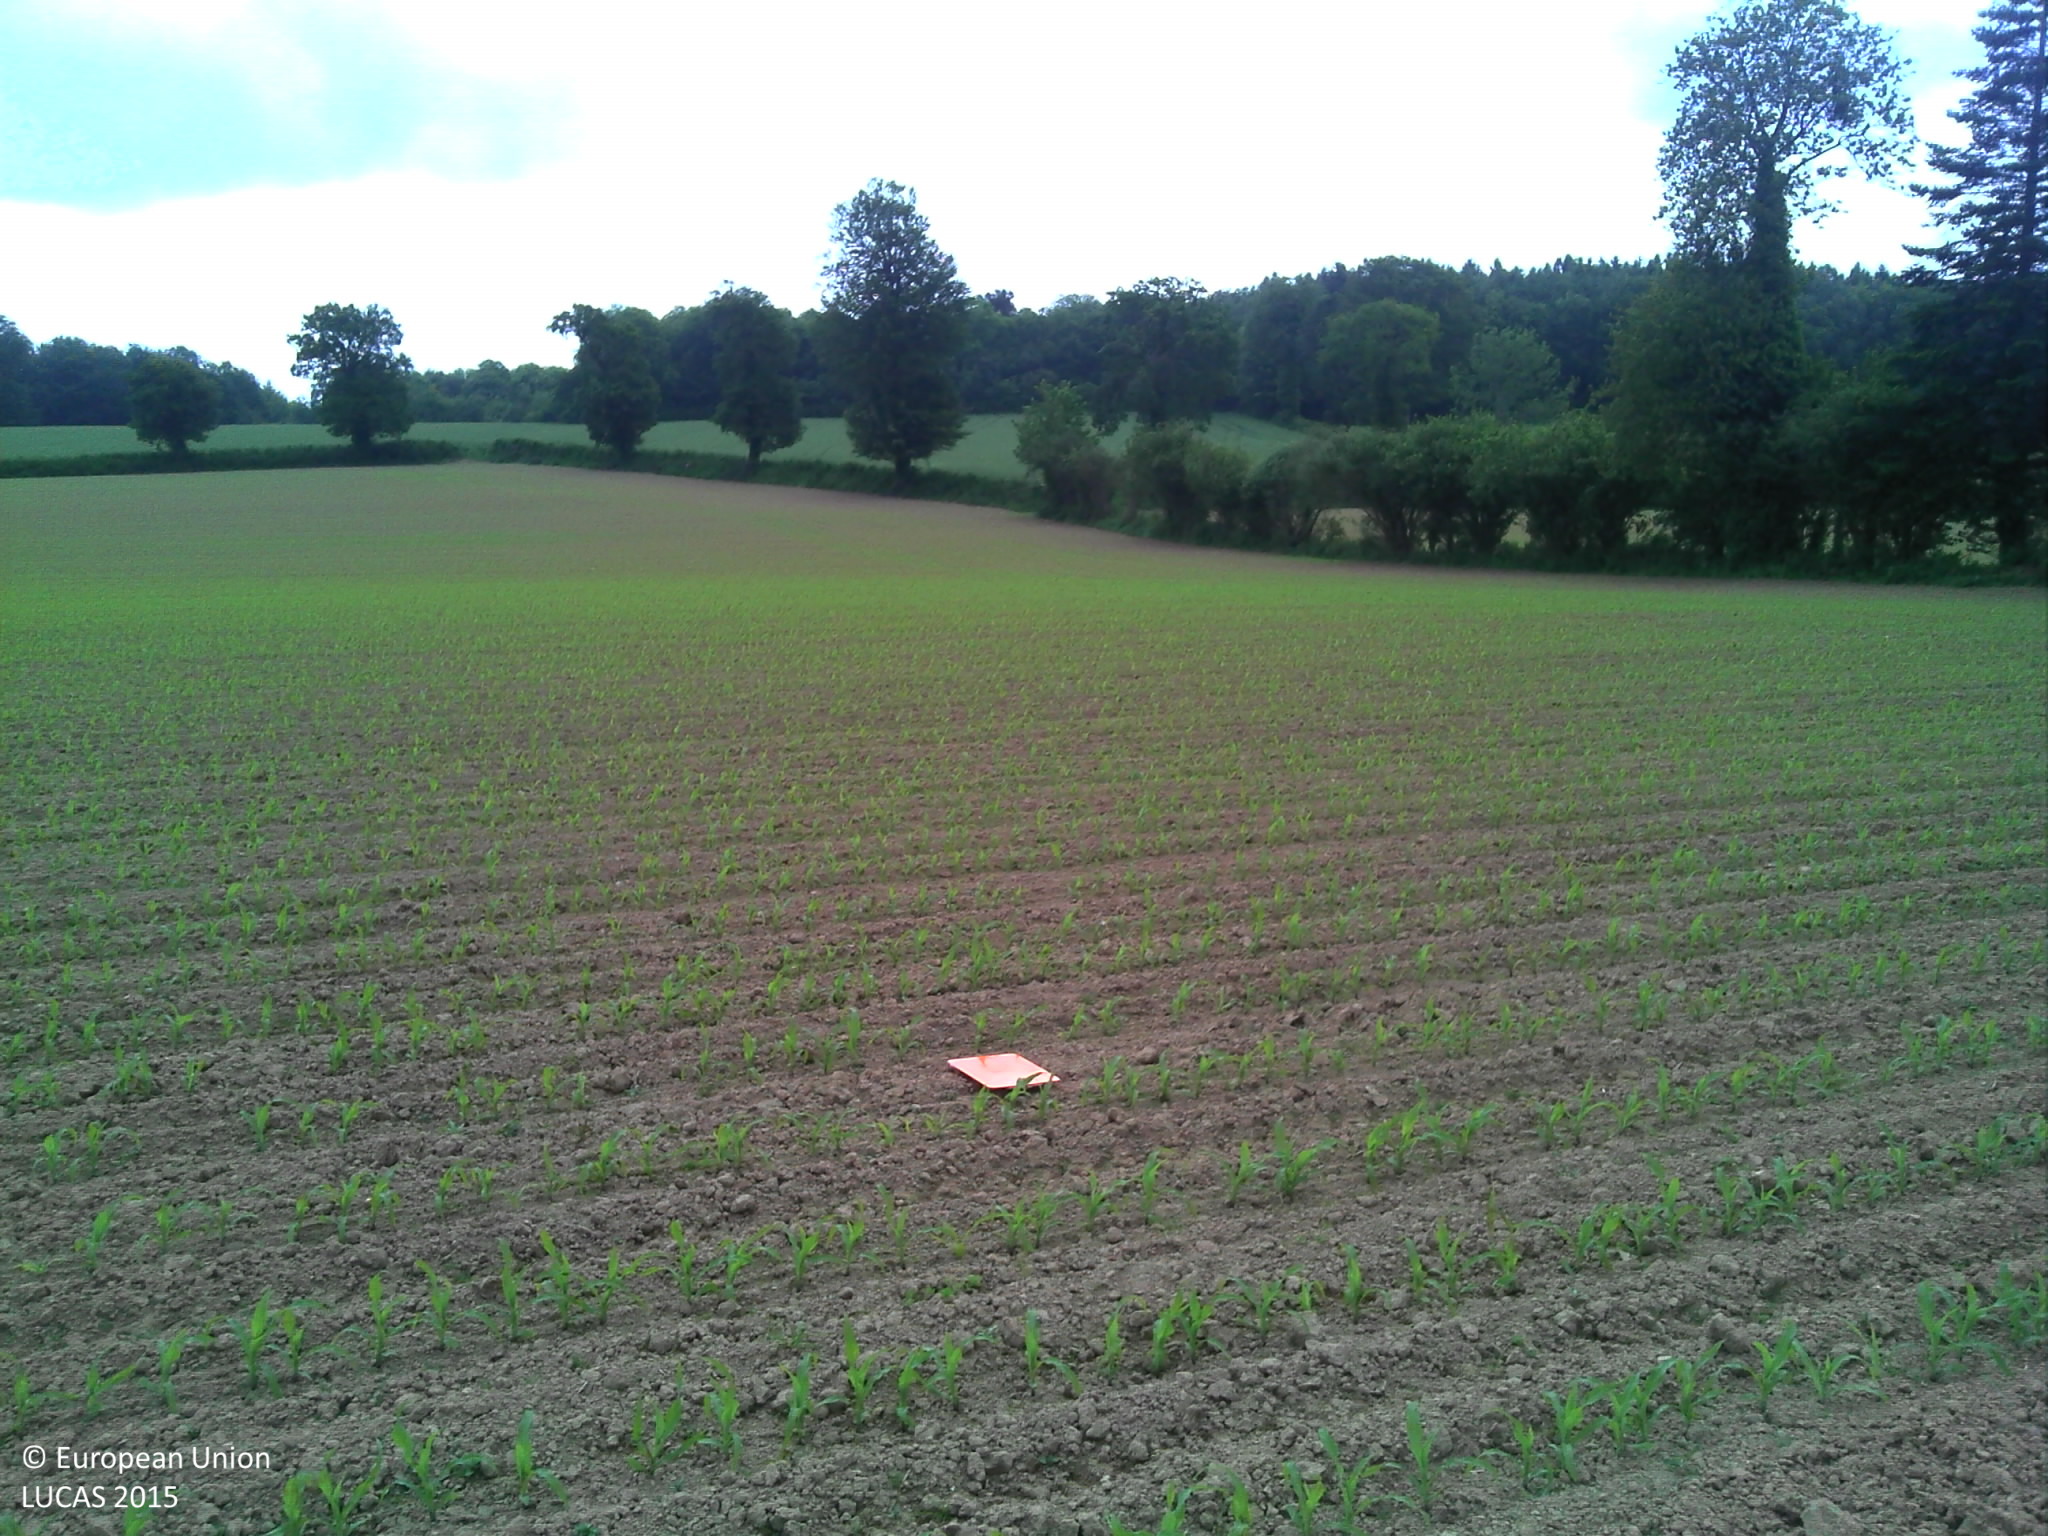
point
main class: Cropland
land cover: Maize
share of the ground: < 10 %
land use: Agriculture (excluding fallow land and kitchen gardens)
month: June
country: FR
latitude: 49.5449
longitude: -1.5069
